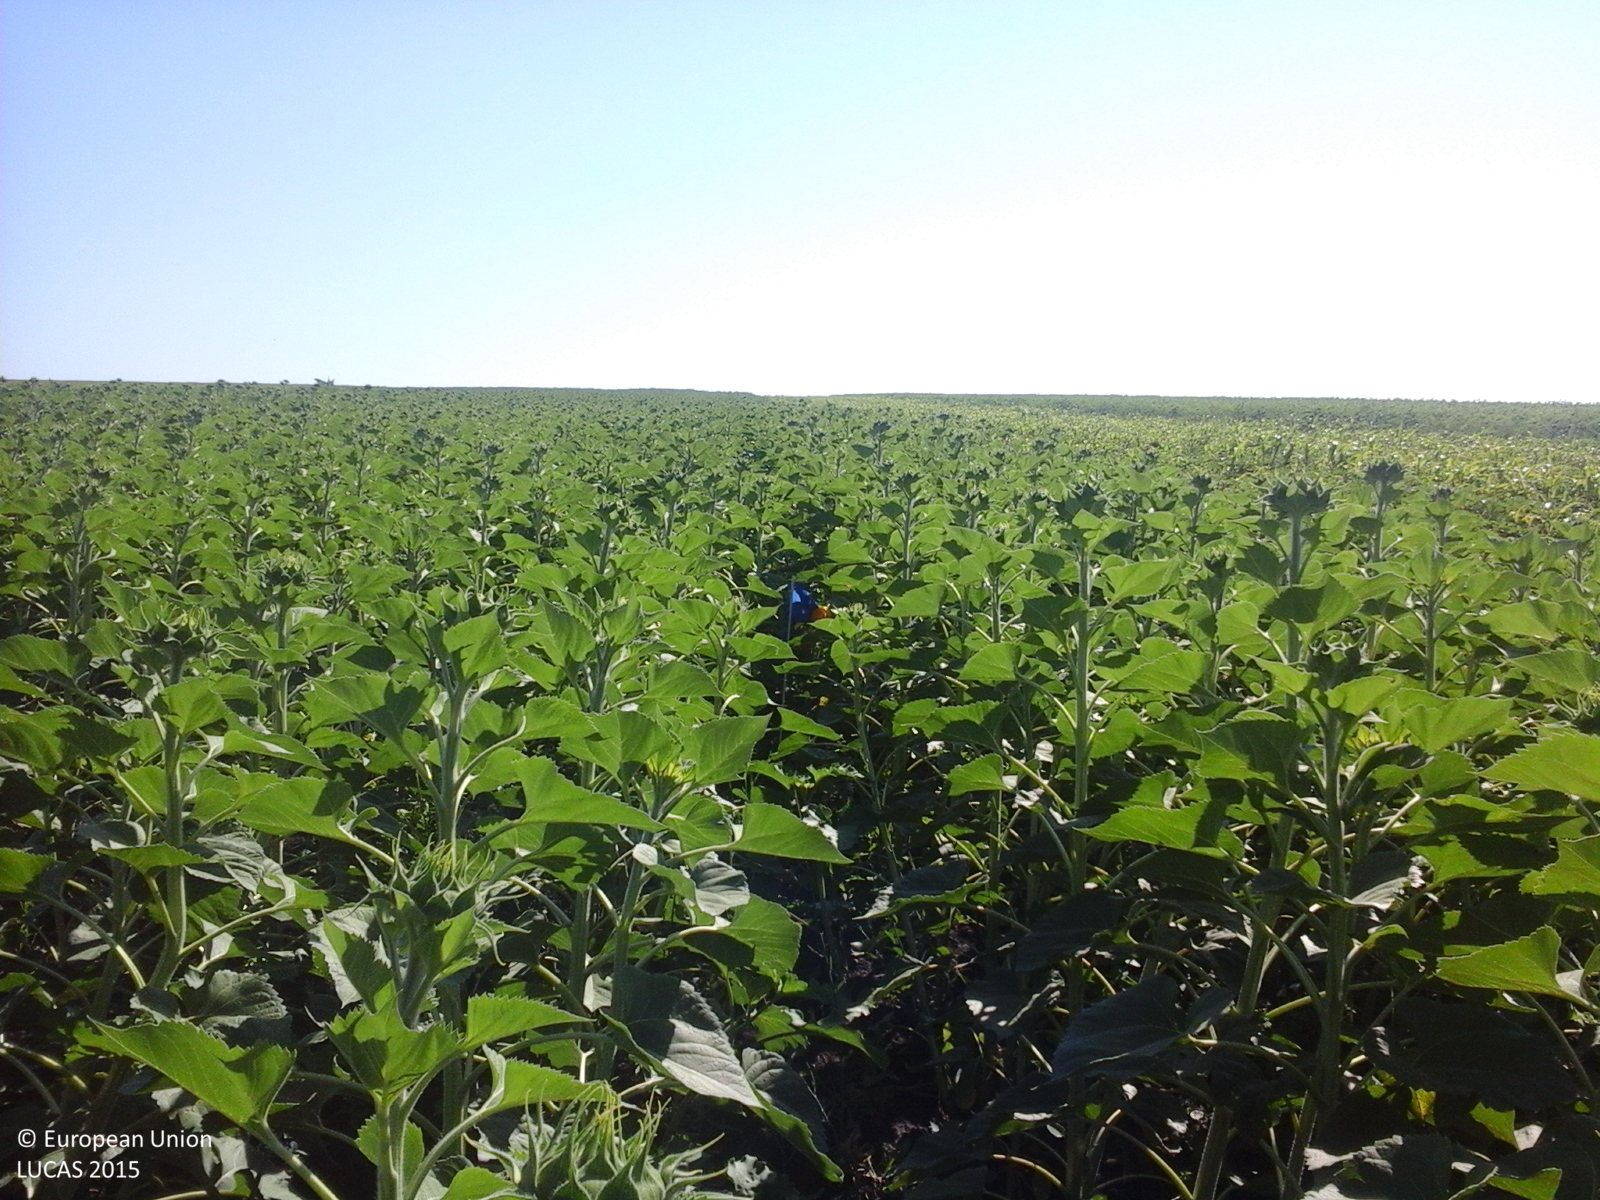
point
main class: Cropland
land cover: Sunflower
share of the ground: > 75 %
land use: Agriculture (excluding fallow land and kitchen gardens)
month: June
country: RO
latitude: 47.7235
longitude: 27.0783
